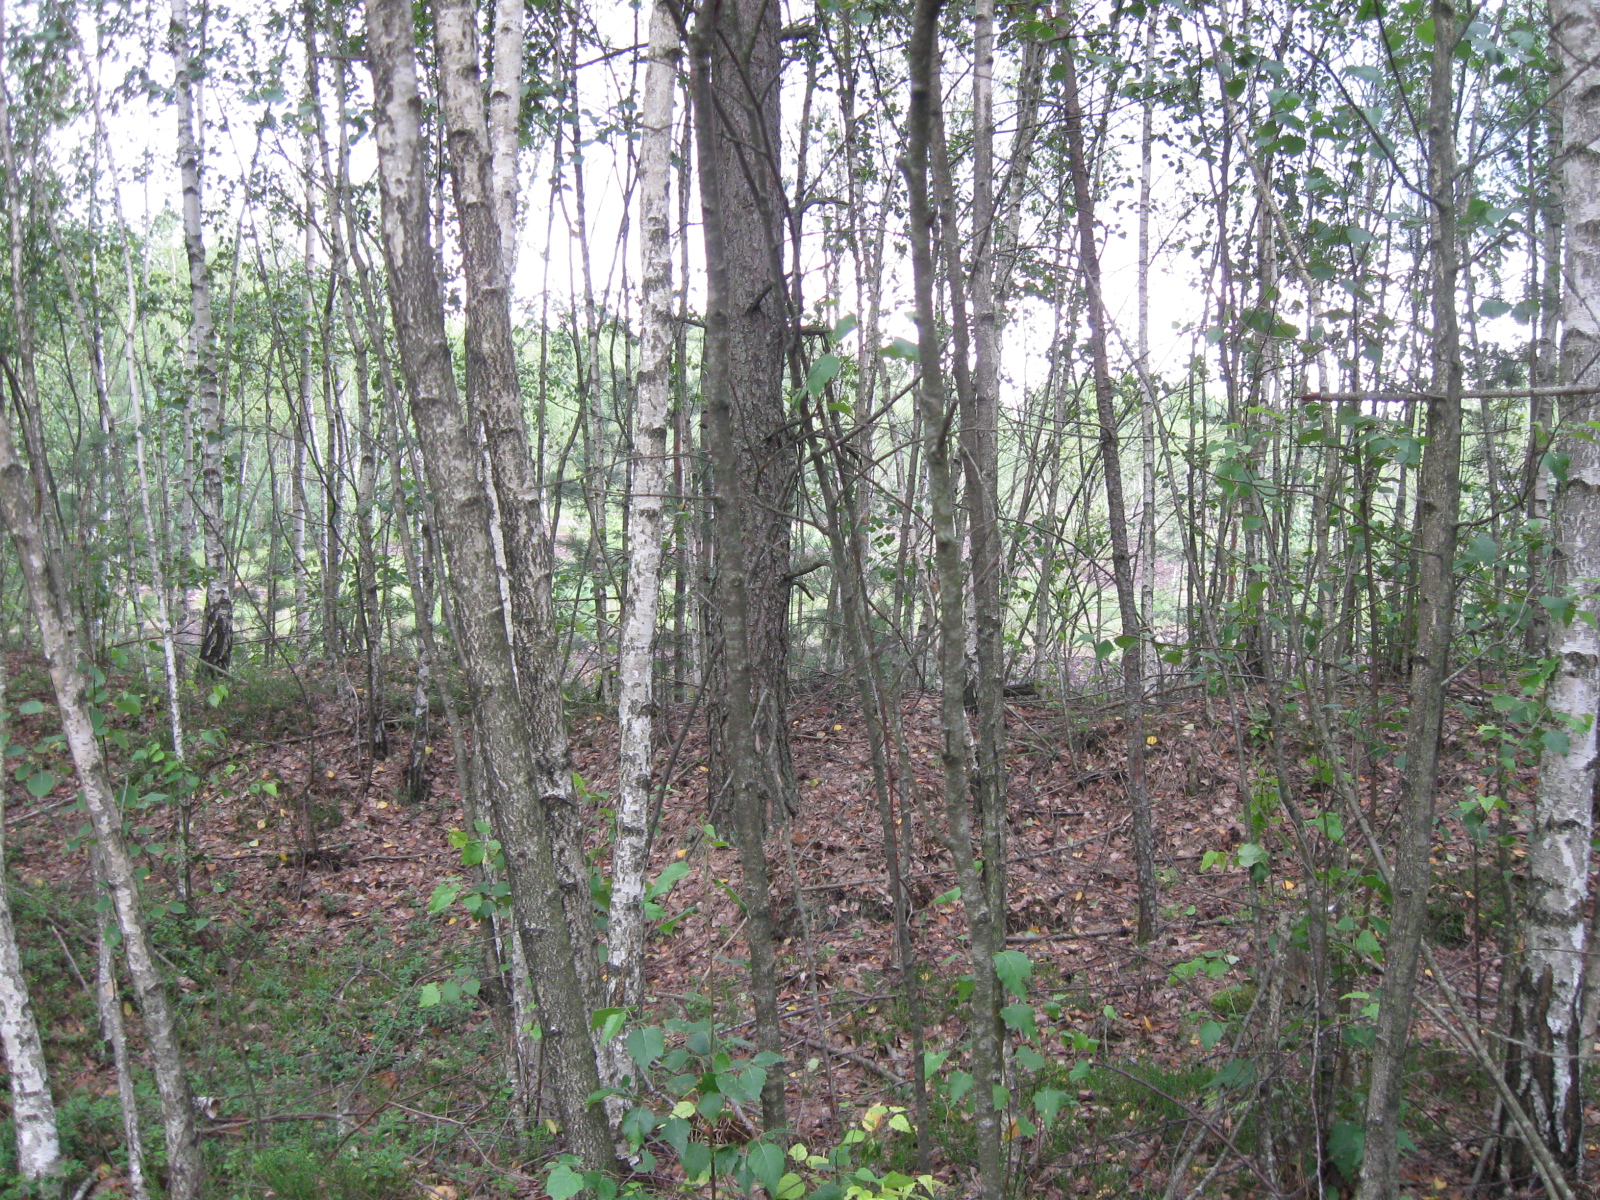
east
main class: Woodland
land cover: Pine dominated mixed woodland
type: mire and swamp forests
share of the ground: > 75 %
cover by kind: broadleaved forest trees 55 %, coniferous forest trees 25 %, herbaceous plants 15 %, shrubs 5 %
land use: Forestry
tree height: > 5 m
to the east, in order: Pine dominated mixed woodland; Ditches and canals; Peatbogs; Pine dominated mixed woodland
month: July
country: LT
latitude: 54.8754
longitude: 23.5947
